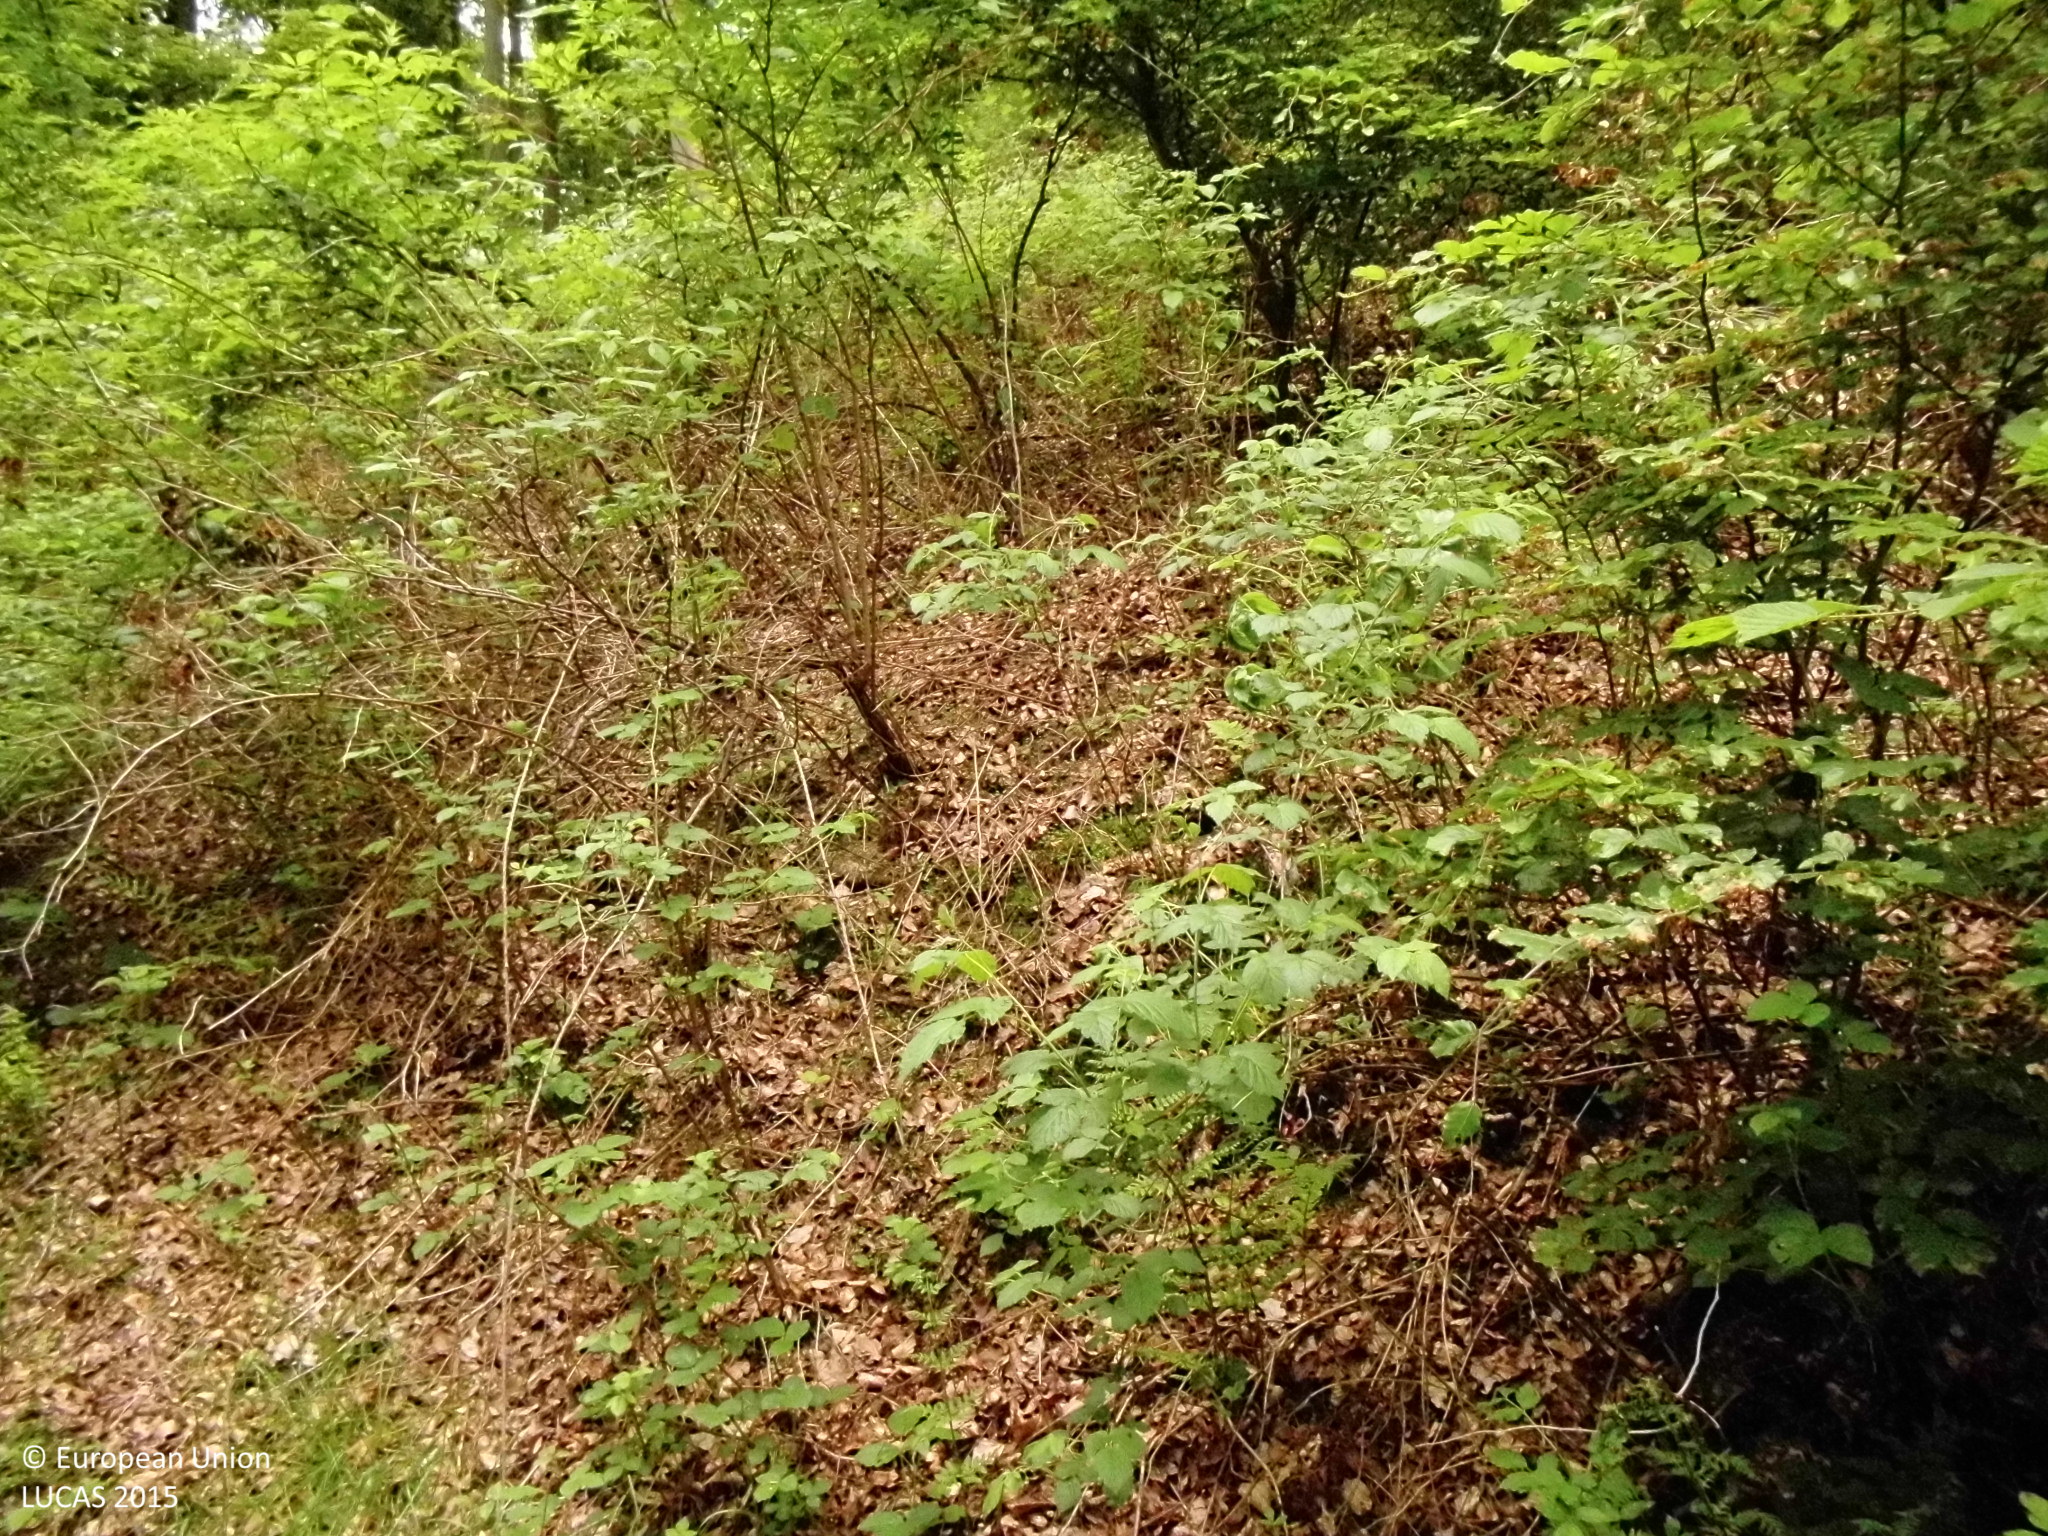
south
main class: Woodland
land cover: Broadleaved woodland
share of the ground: 50 - 75 %
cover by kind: broadleaved forest trees 70 %, shrubs 15 %, herbaceous plants 15 %
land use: Forestry
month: May
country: DE
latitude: 50.5527
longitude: 7.5021
